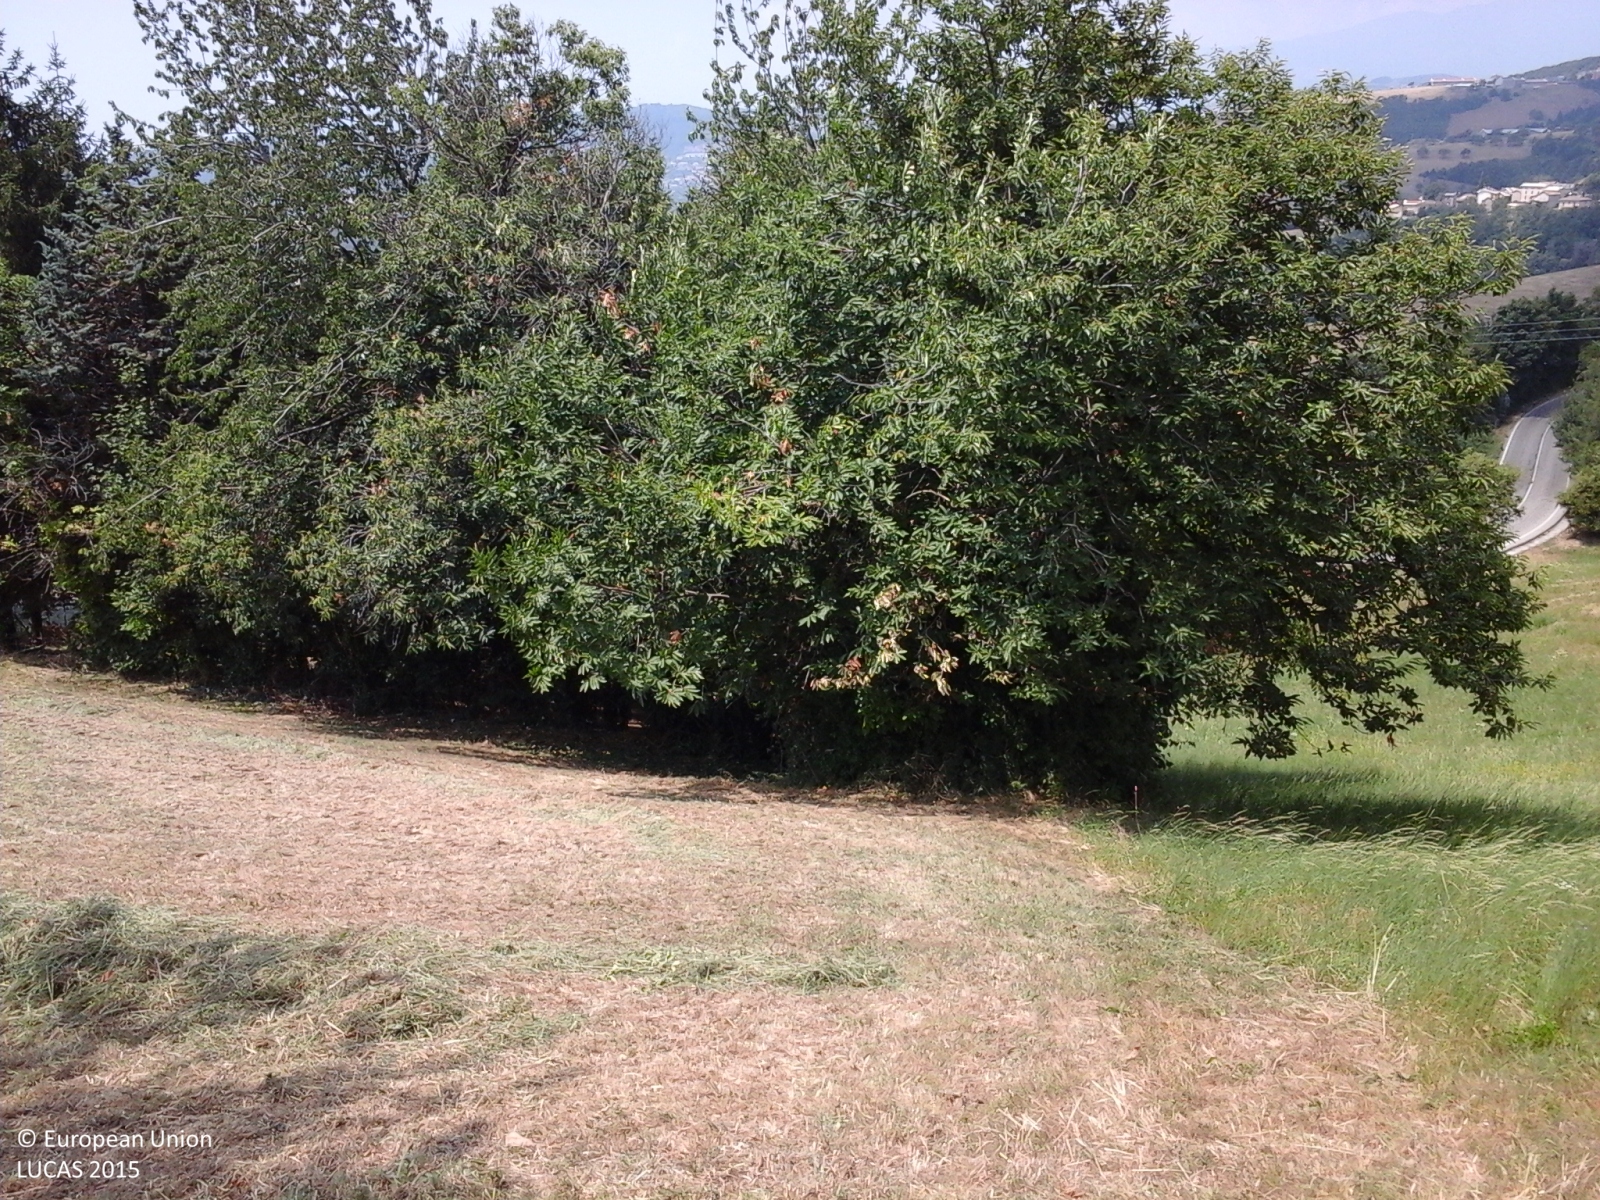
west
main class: Grassland
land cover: Grassland with sparse tree/shrub cover
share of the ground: > 75 %
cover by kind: herbaceous plants 85 %, shrubs 10 %, broadleaved forest trees 5 %
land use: Agriculture (excluding fallow land and kitchen gardens)
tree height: > 5 m
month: July
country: IT
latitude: 45.5894
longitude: 11.0366
